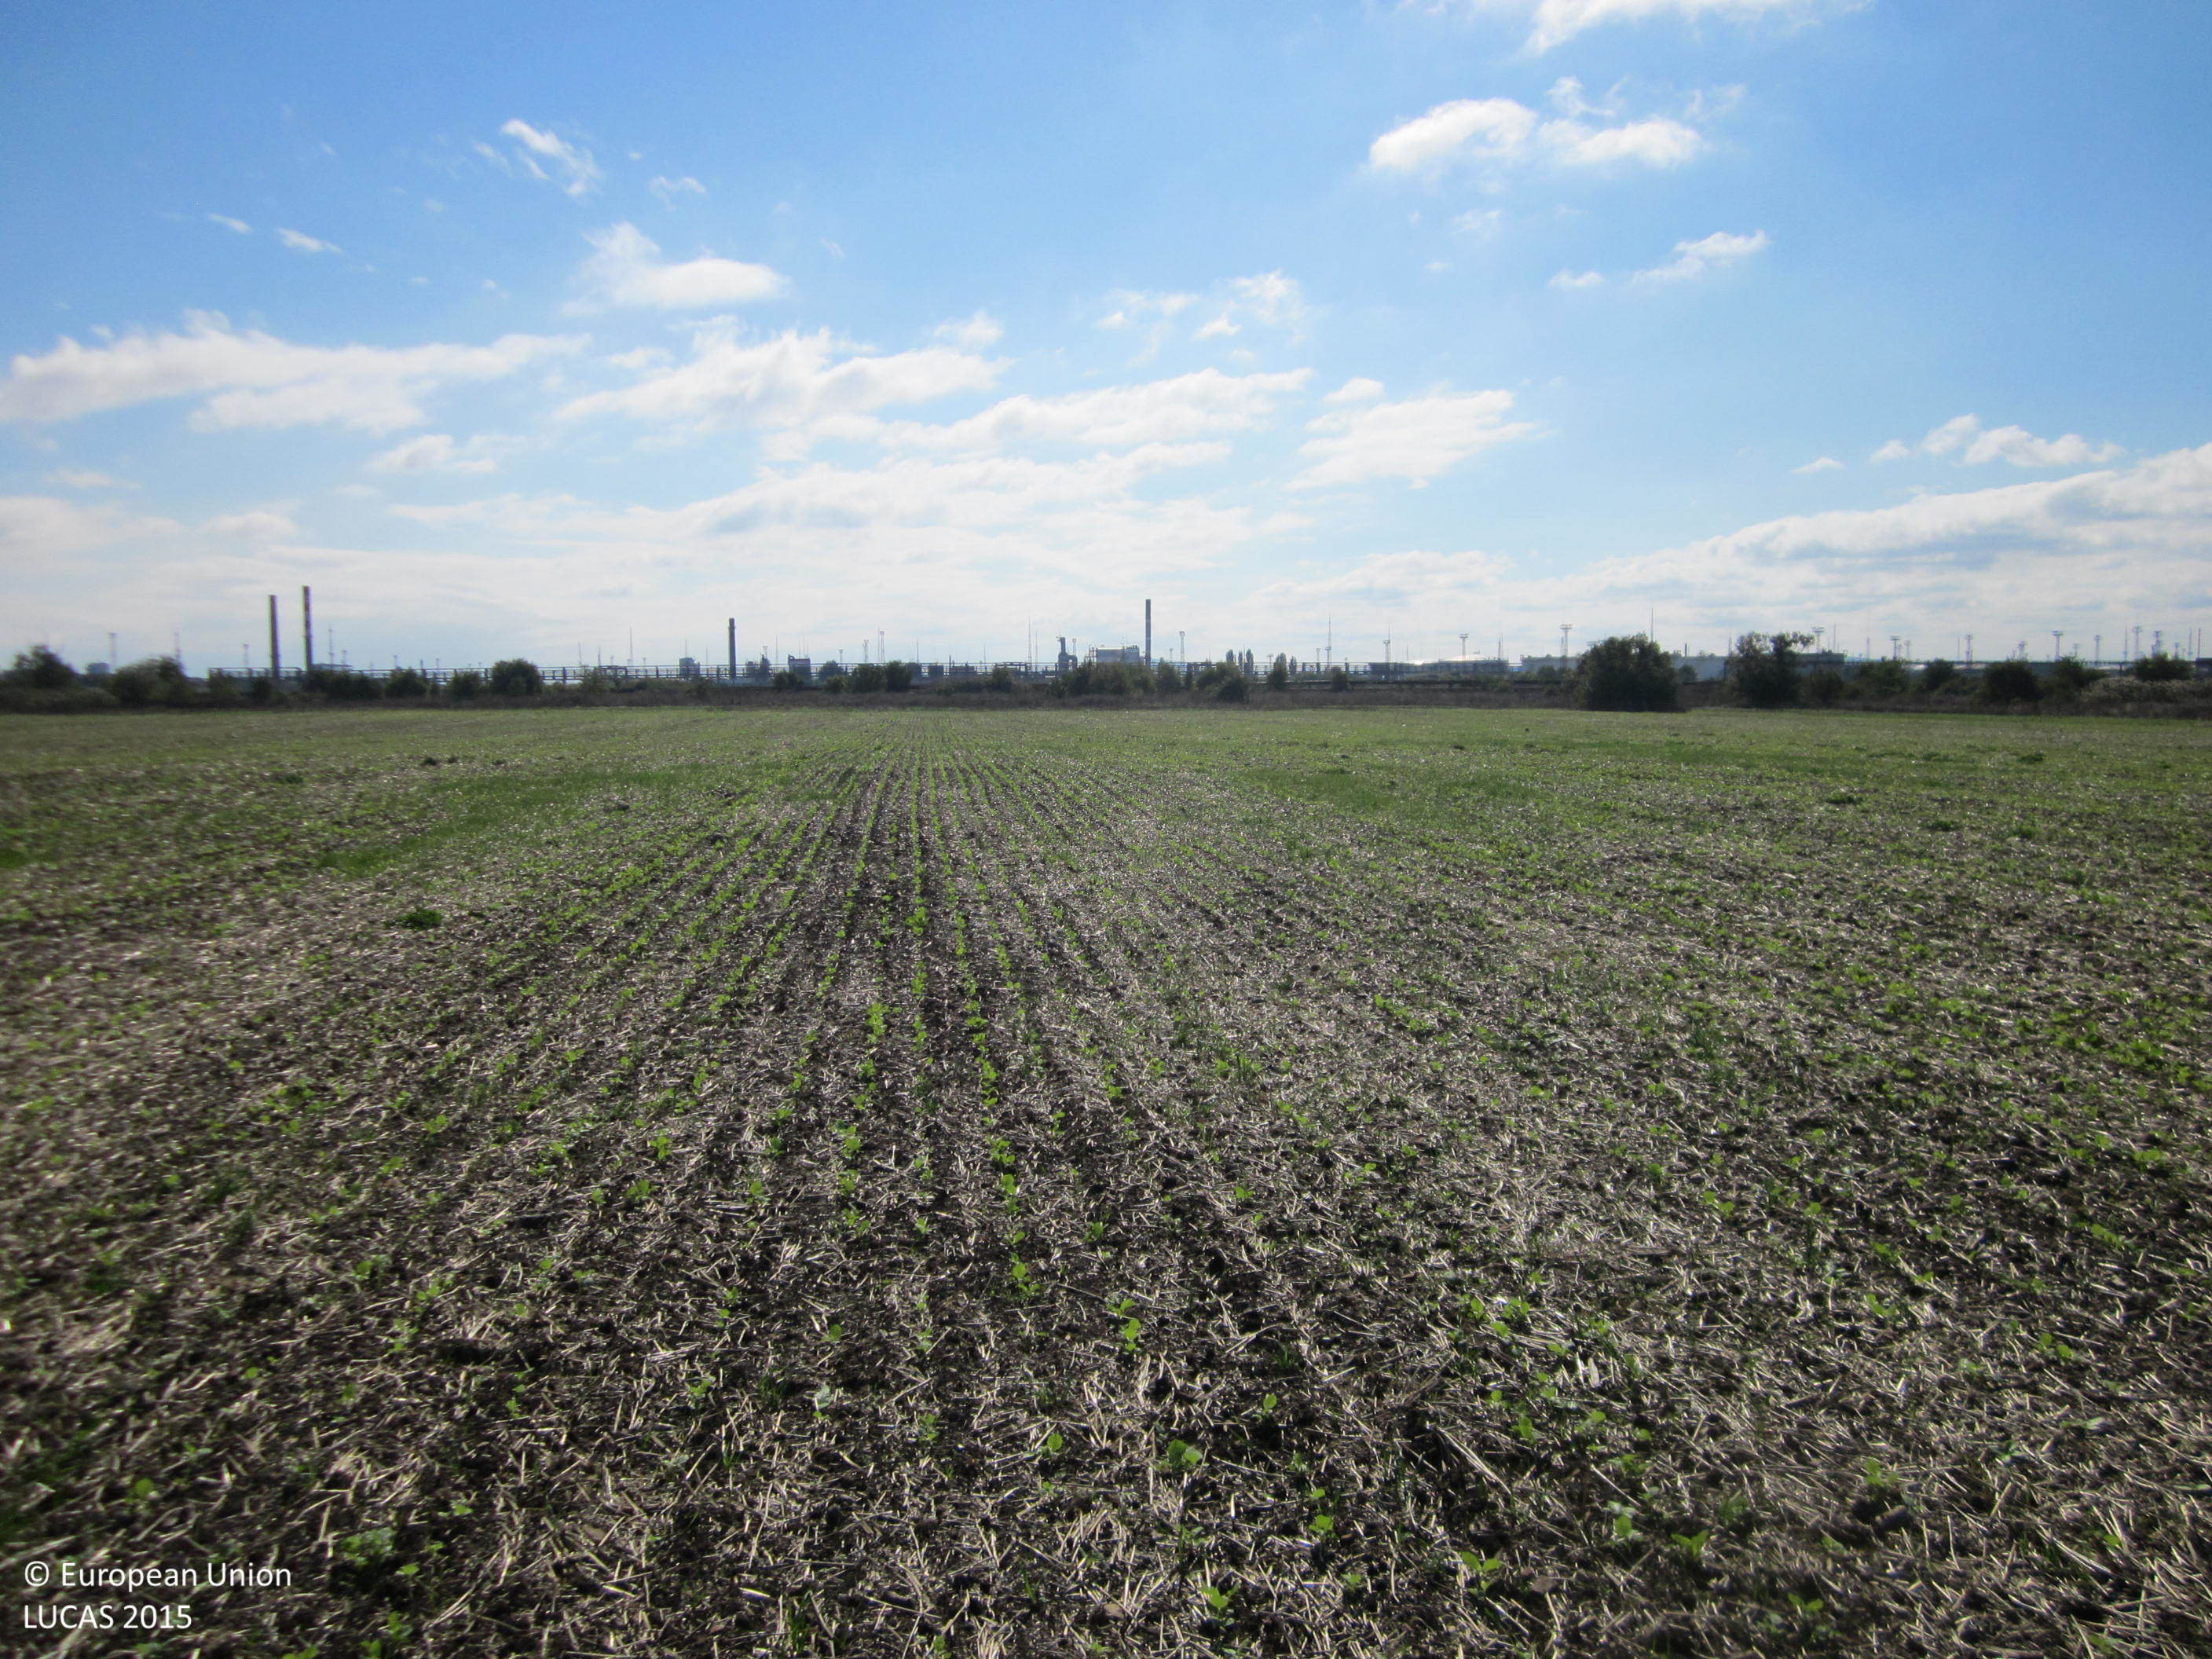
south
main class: Cropland
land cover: Common wheat
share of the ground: 10 - 25 %
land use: Agriculture (excluding fallow land and kitchen gardens)
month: October
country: BG
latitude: 42.5487
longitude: 27.3211
